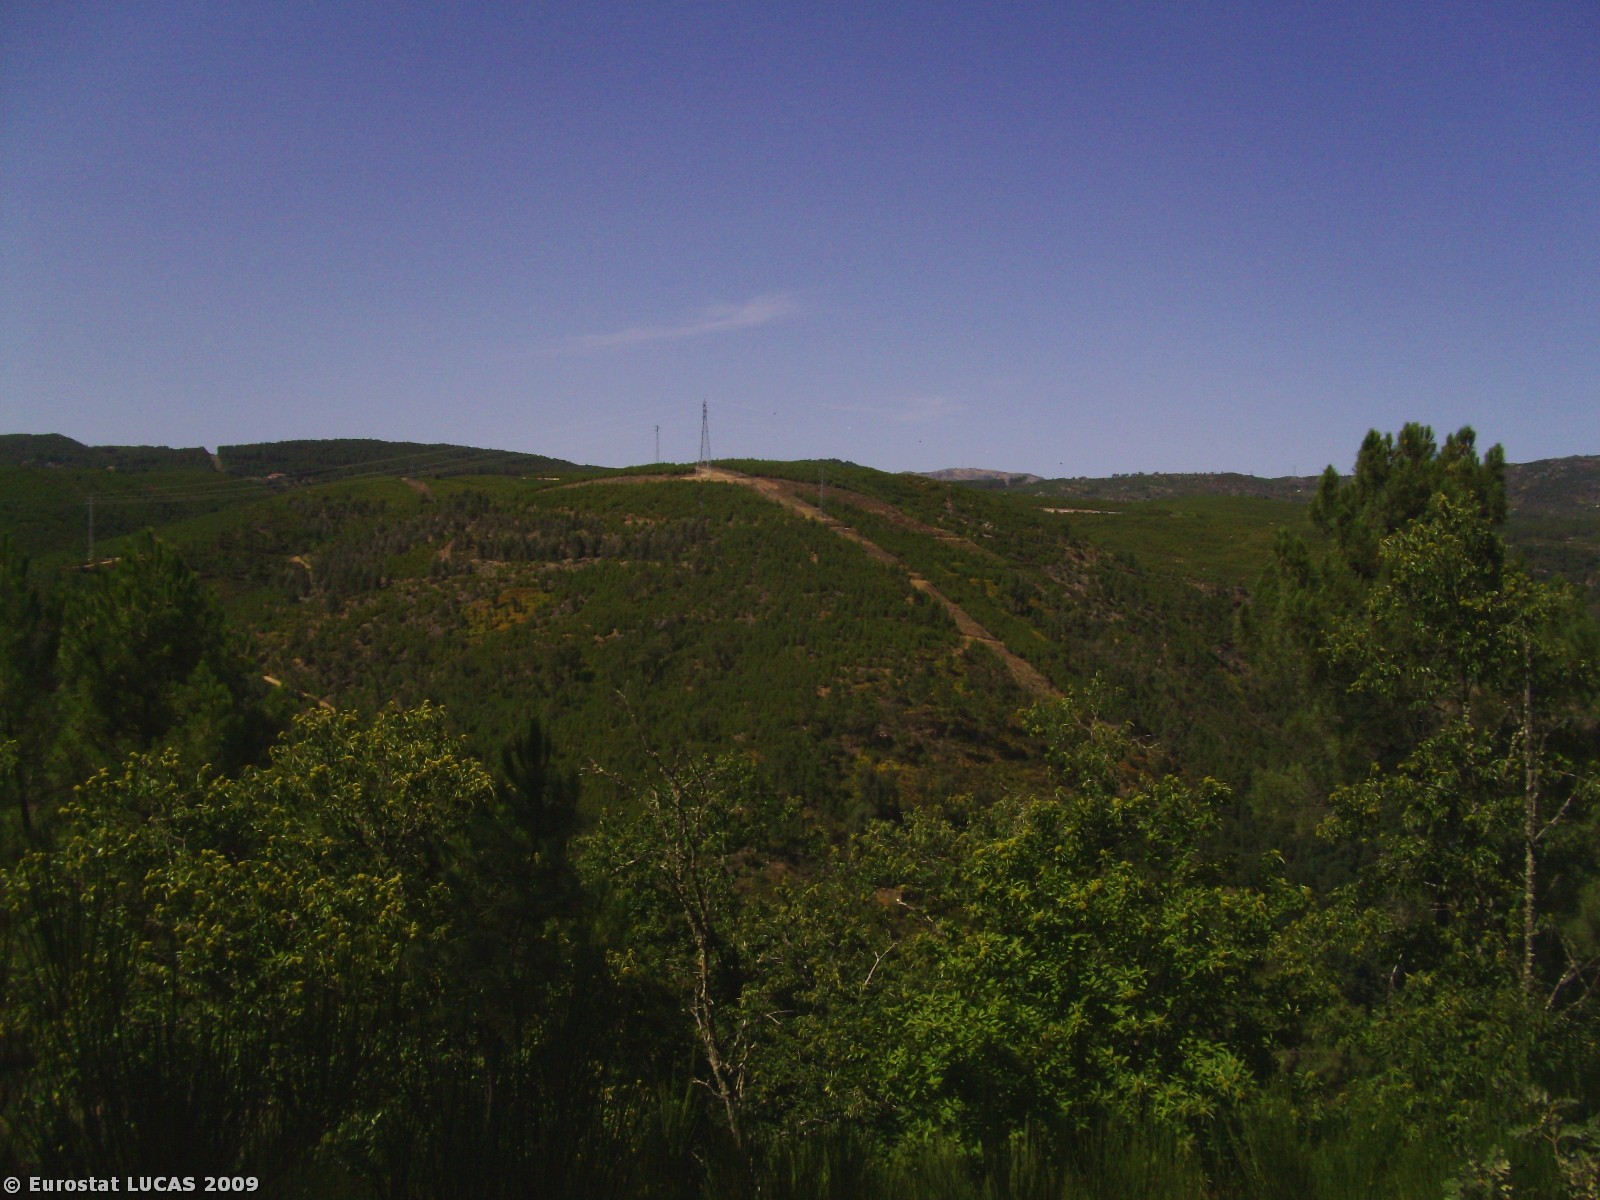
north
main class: Shrubland
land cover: Shrubland with sparse tree cover
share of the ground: > 75 %
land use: Forestry
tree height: > 5 m
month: August
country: PT
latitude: 41.6512
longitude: -7.6031
